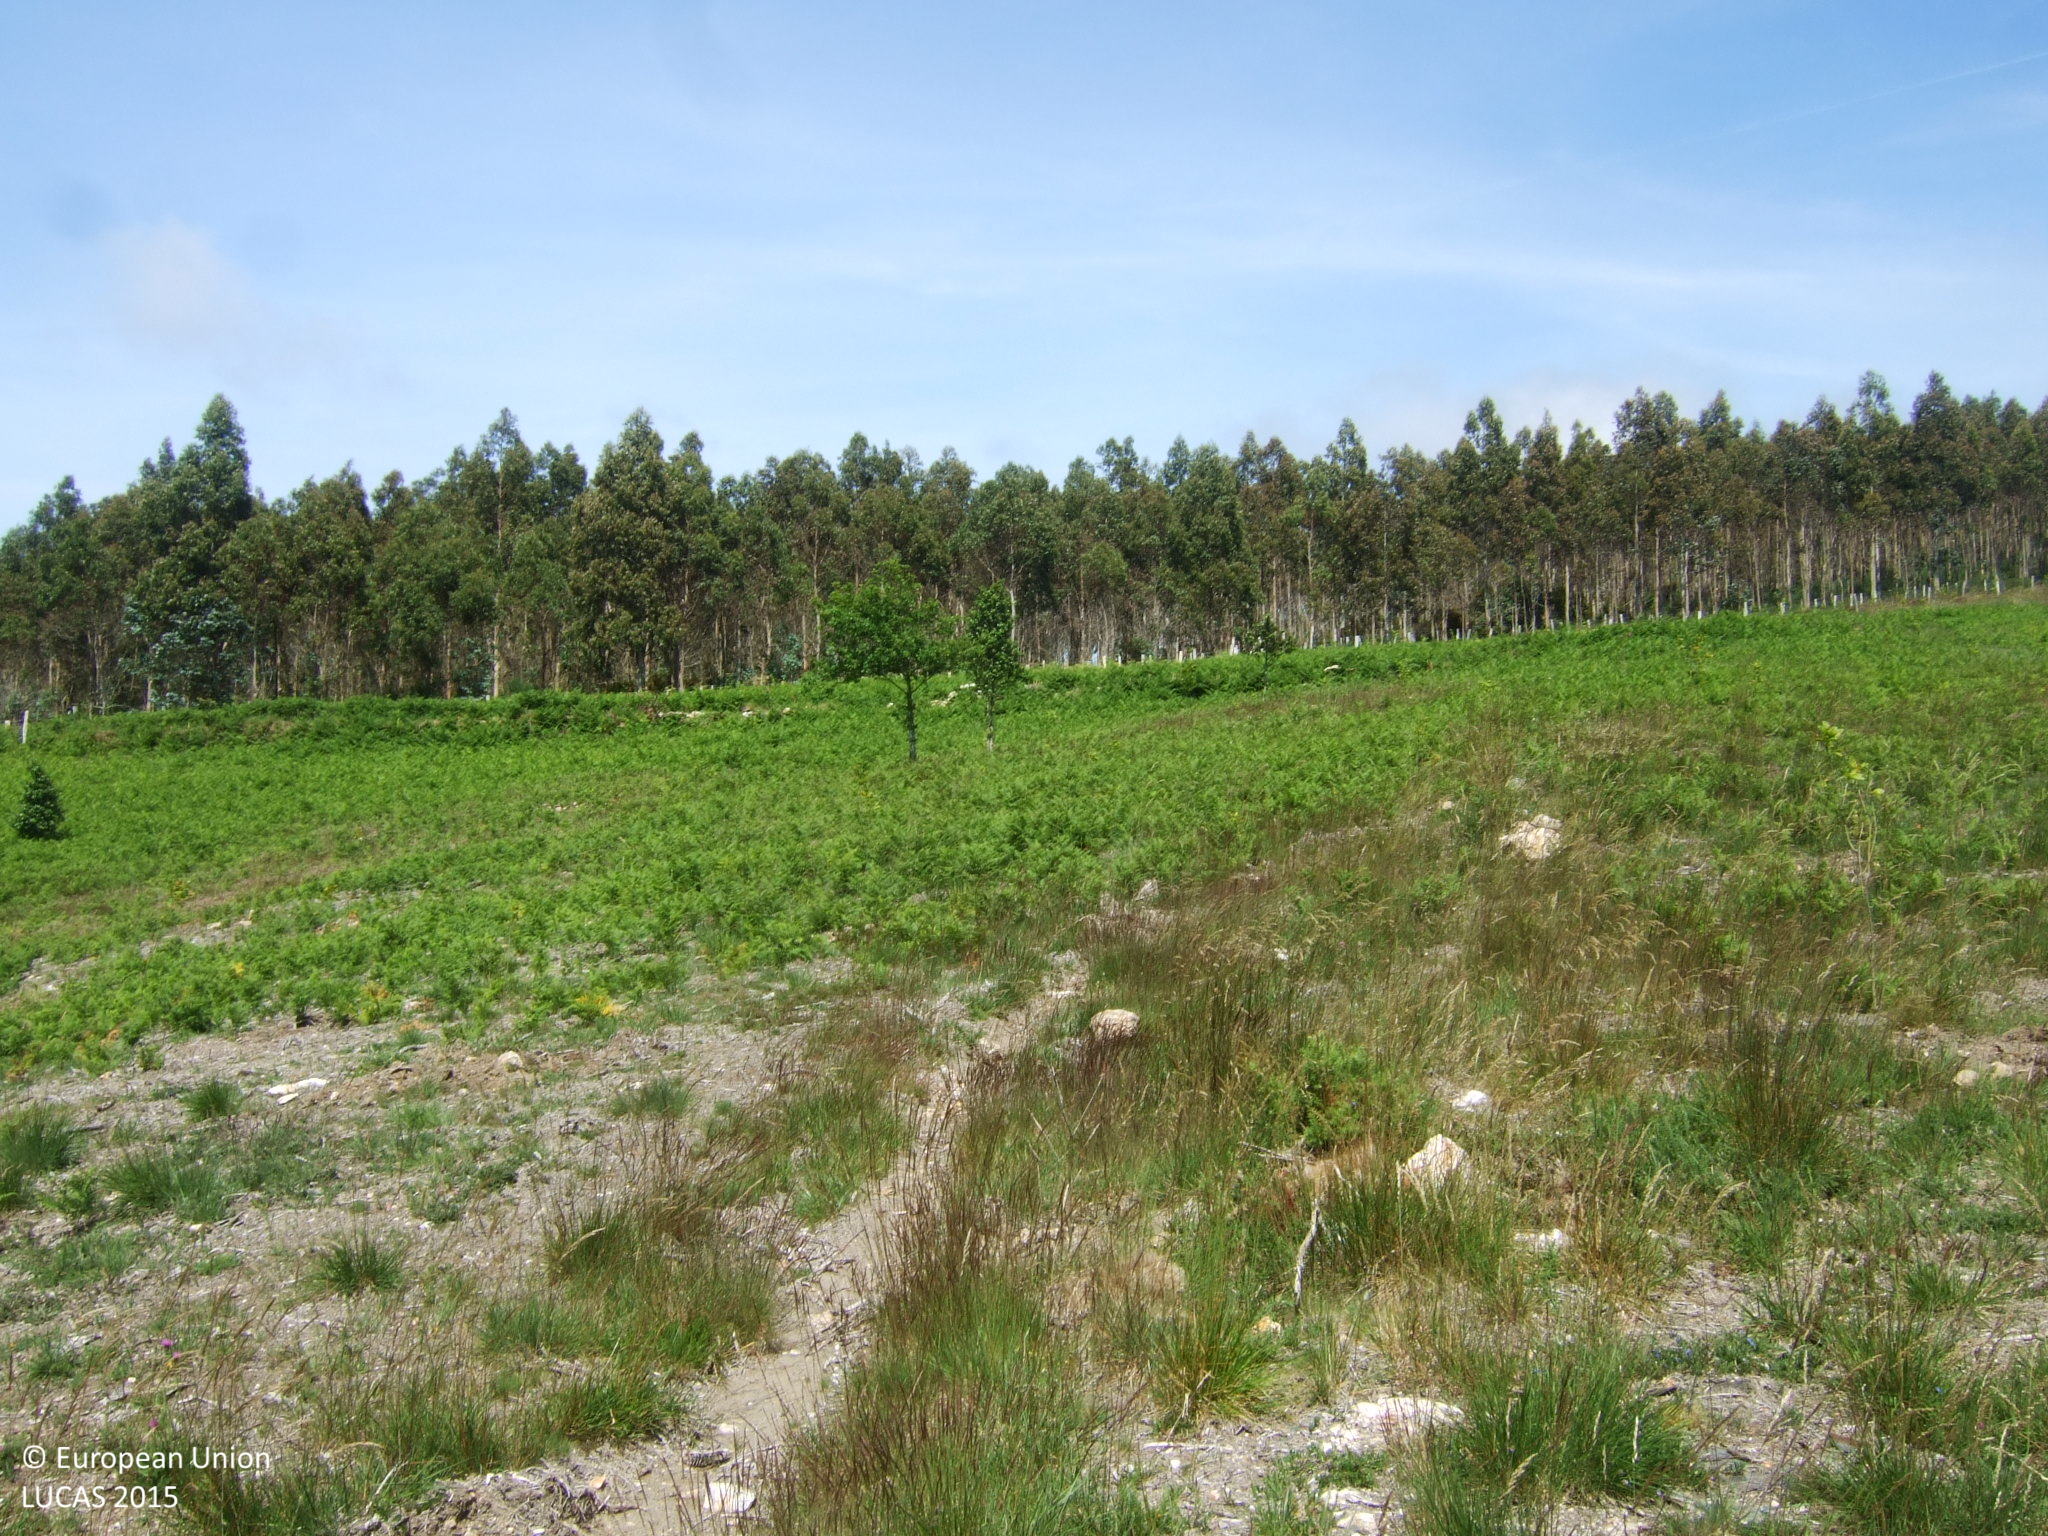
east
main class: Grassland
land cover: Grassland with sparse tree/shrub cover
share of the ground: 50 - 75 %
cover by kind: herbaceous plants 60 %, unconsolidated bare surface 25 %, shrubs 10 %, broadleaved forest trees 5 %
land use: Forestry
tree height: < 5 m
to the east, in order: Grassland with sparse tree/shrub cover; Fences; Broadleaved woodland; Tracks
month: June
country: ES
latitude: 43.4557
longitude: -7.8247
